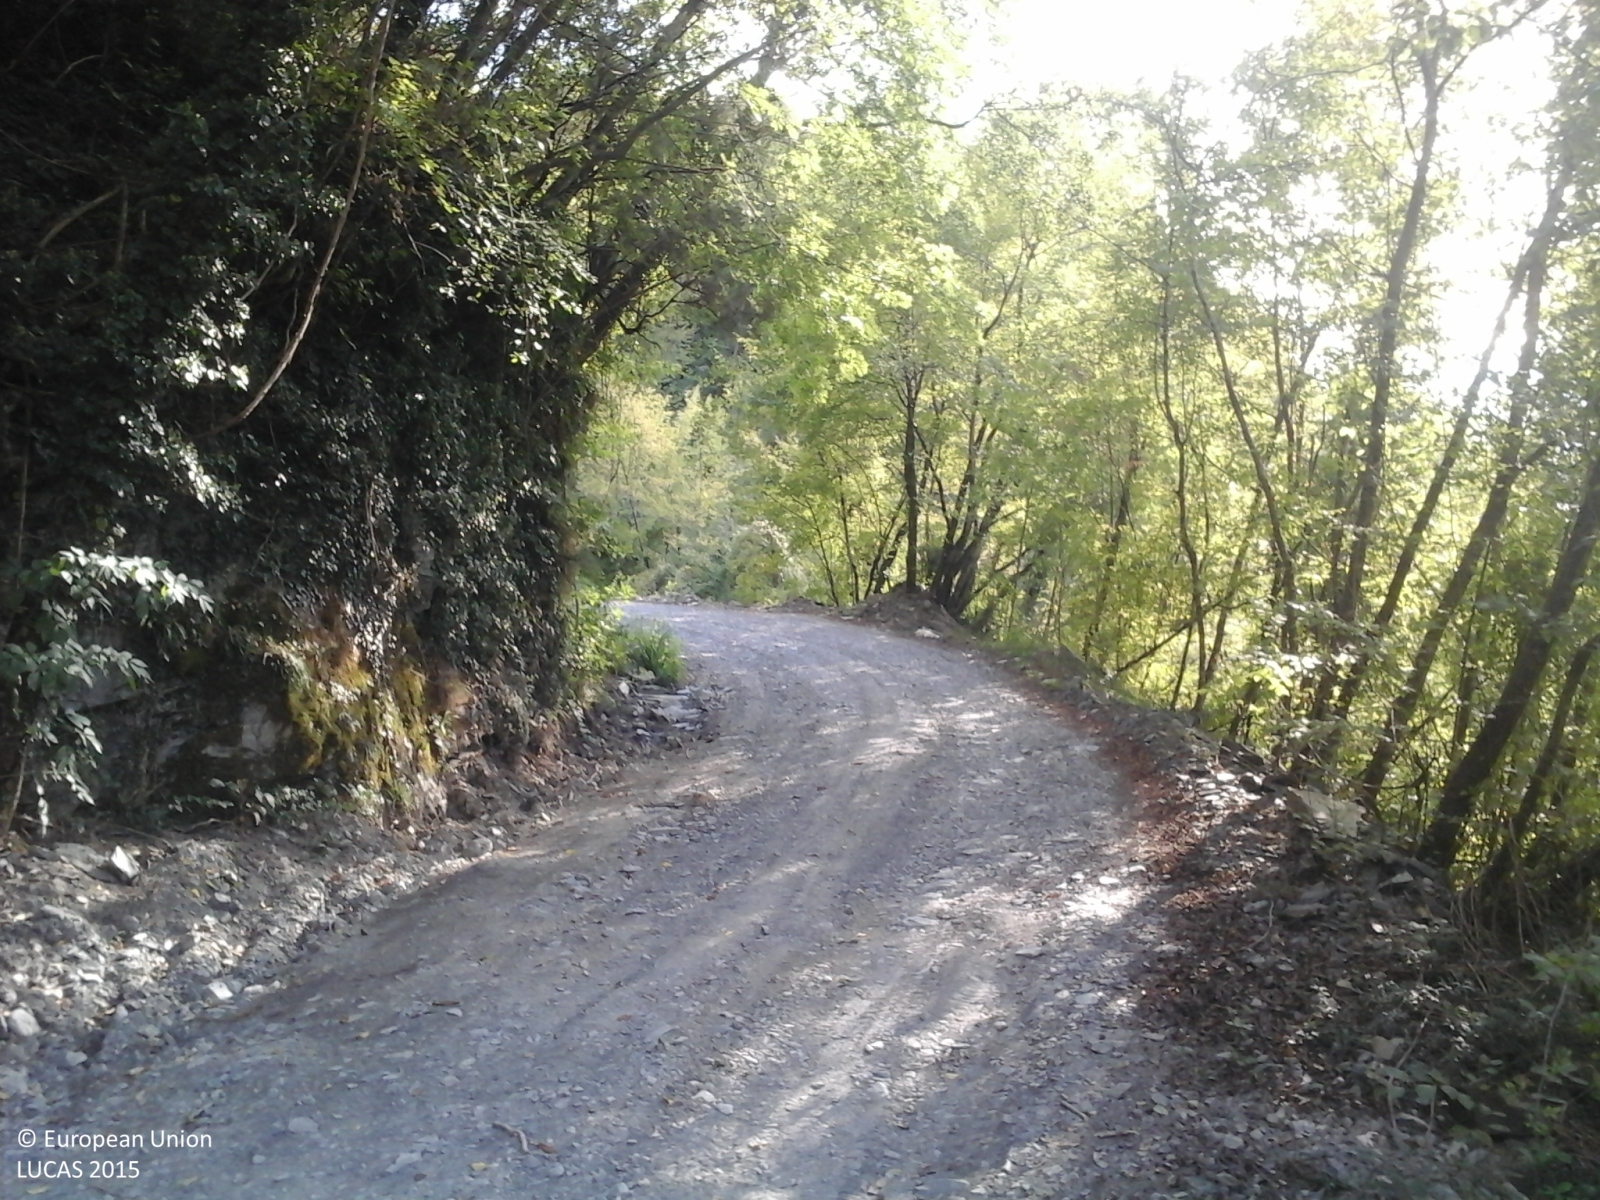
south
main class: Woodland
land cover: Broadleaved woodland
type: thermophilous deciduous forest
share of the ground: > 75 %
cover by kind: broadleaved forest trees 90 %, herbaceous plants 10 %
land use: Semi-natural and natural areas not in use
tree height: > 5 m
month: September
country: IT
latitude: 44.4201
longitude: 9.2606
